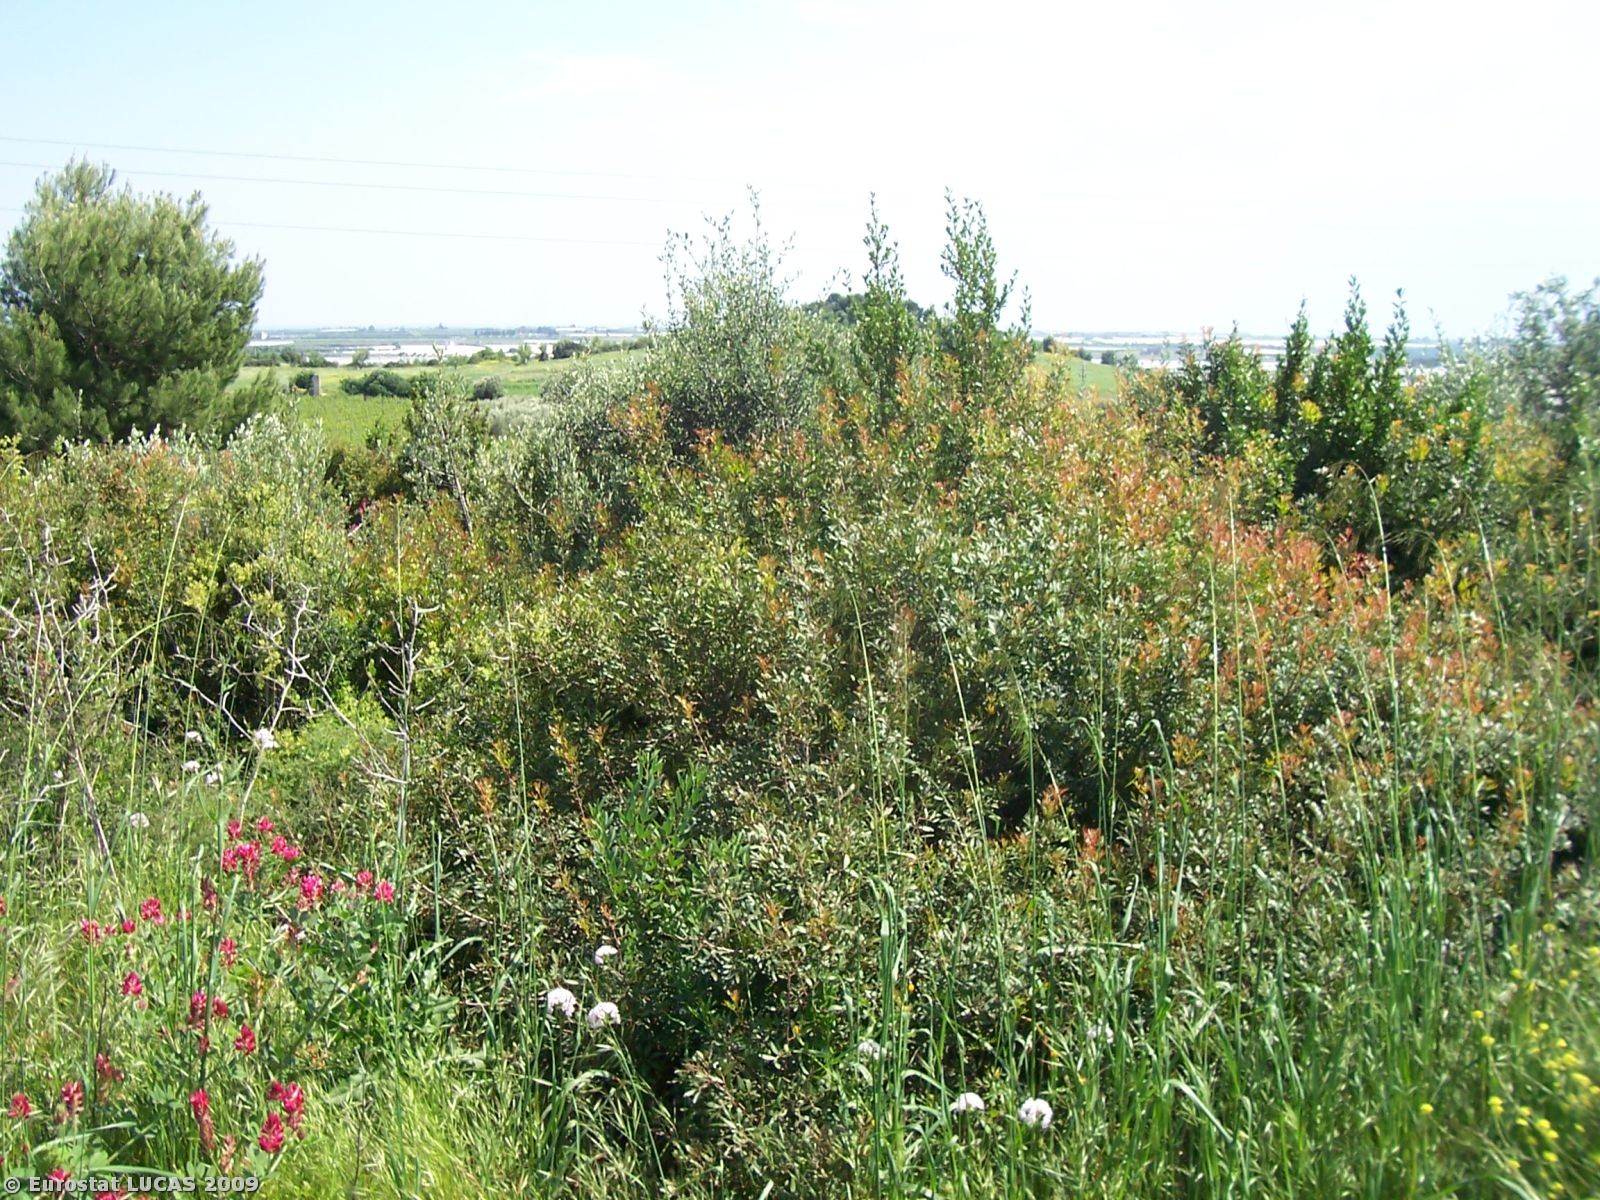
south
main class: Cropland
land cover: Olive groves
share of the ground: 25 - 50 %
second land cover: Spontaneously vegetated surfaces
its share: > 75 %
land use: Agriculture (excluding fallow land and kitchen gardens)
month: May
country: IT
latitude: 40.6042
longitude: 16.9136
